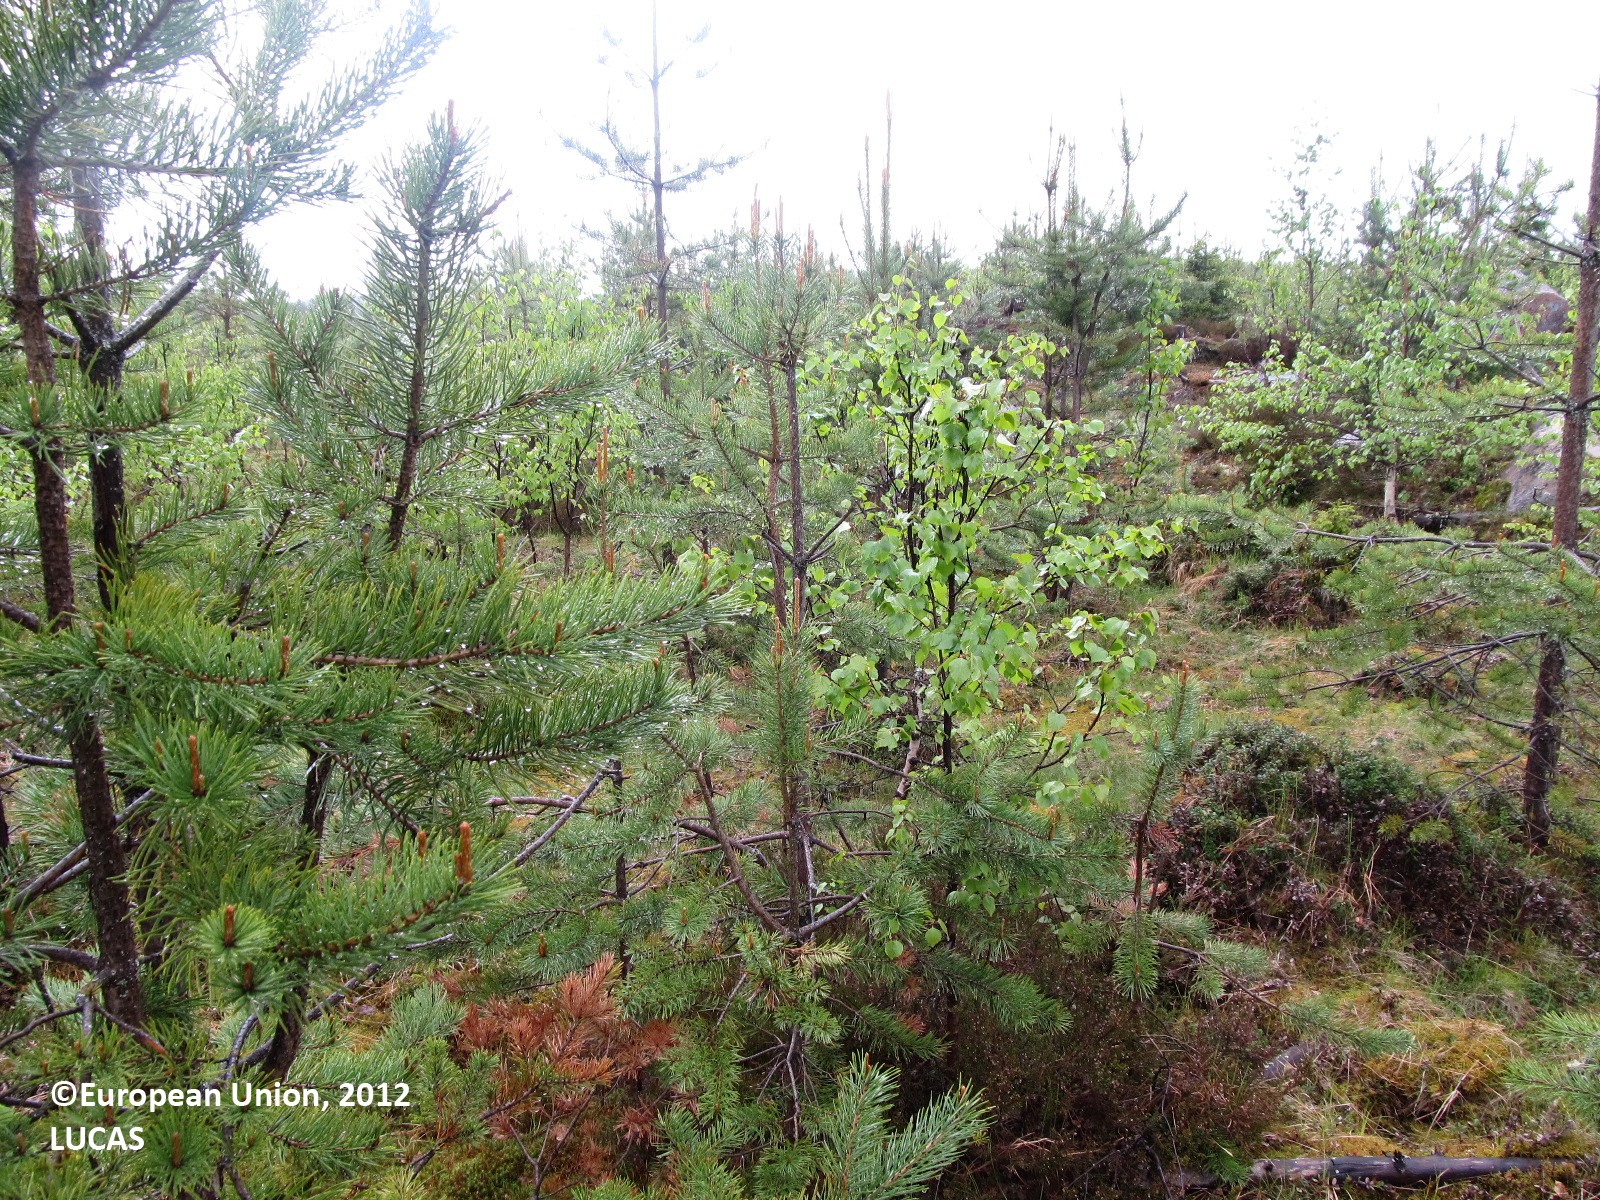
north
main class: Woodland
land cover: Pine dominated mixed woodland
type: boreal forest
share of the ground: 10 - 25 %
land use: Forestry
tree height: < 5 m
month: June
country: FI
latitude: 63.3102
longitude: 28.8220
